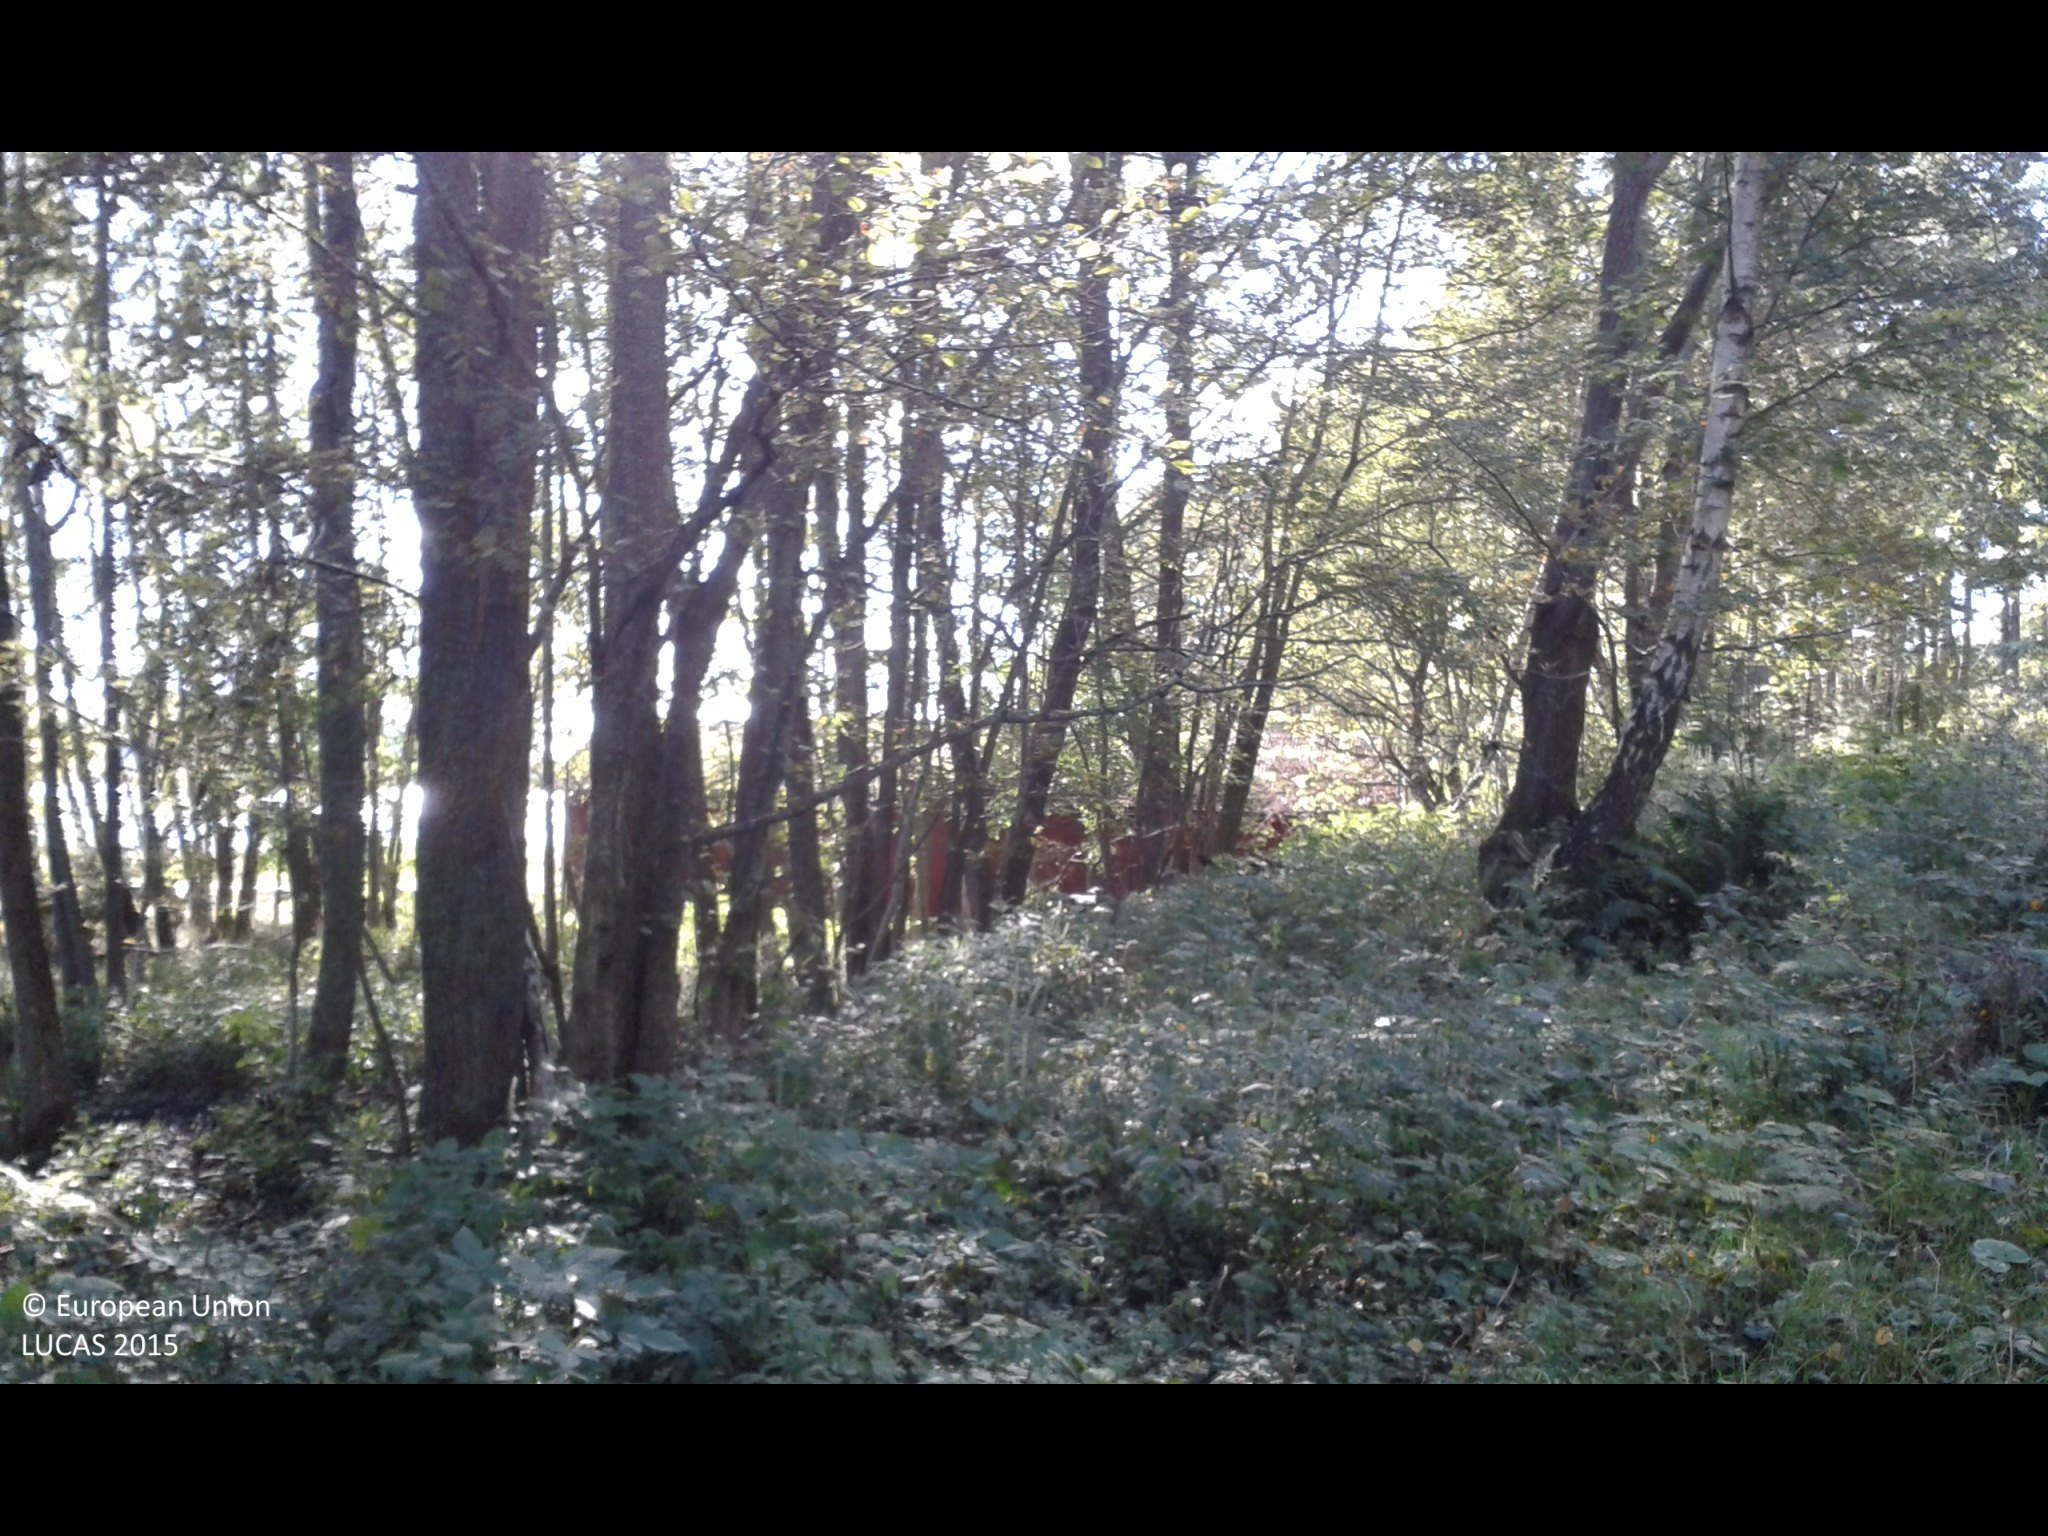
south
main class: Woodland
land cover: Broadleaved woodland
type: hemiboreal forest and nemoral coniferous forest and mixed broadleaved-coniferous forest
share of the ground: > 75 %
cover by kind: broadleaved forest trees 100 %
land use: Amenities, museums, leisure
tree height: > 5 m
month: September
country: SE
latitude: 58.9270
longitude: 17.5892
